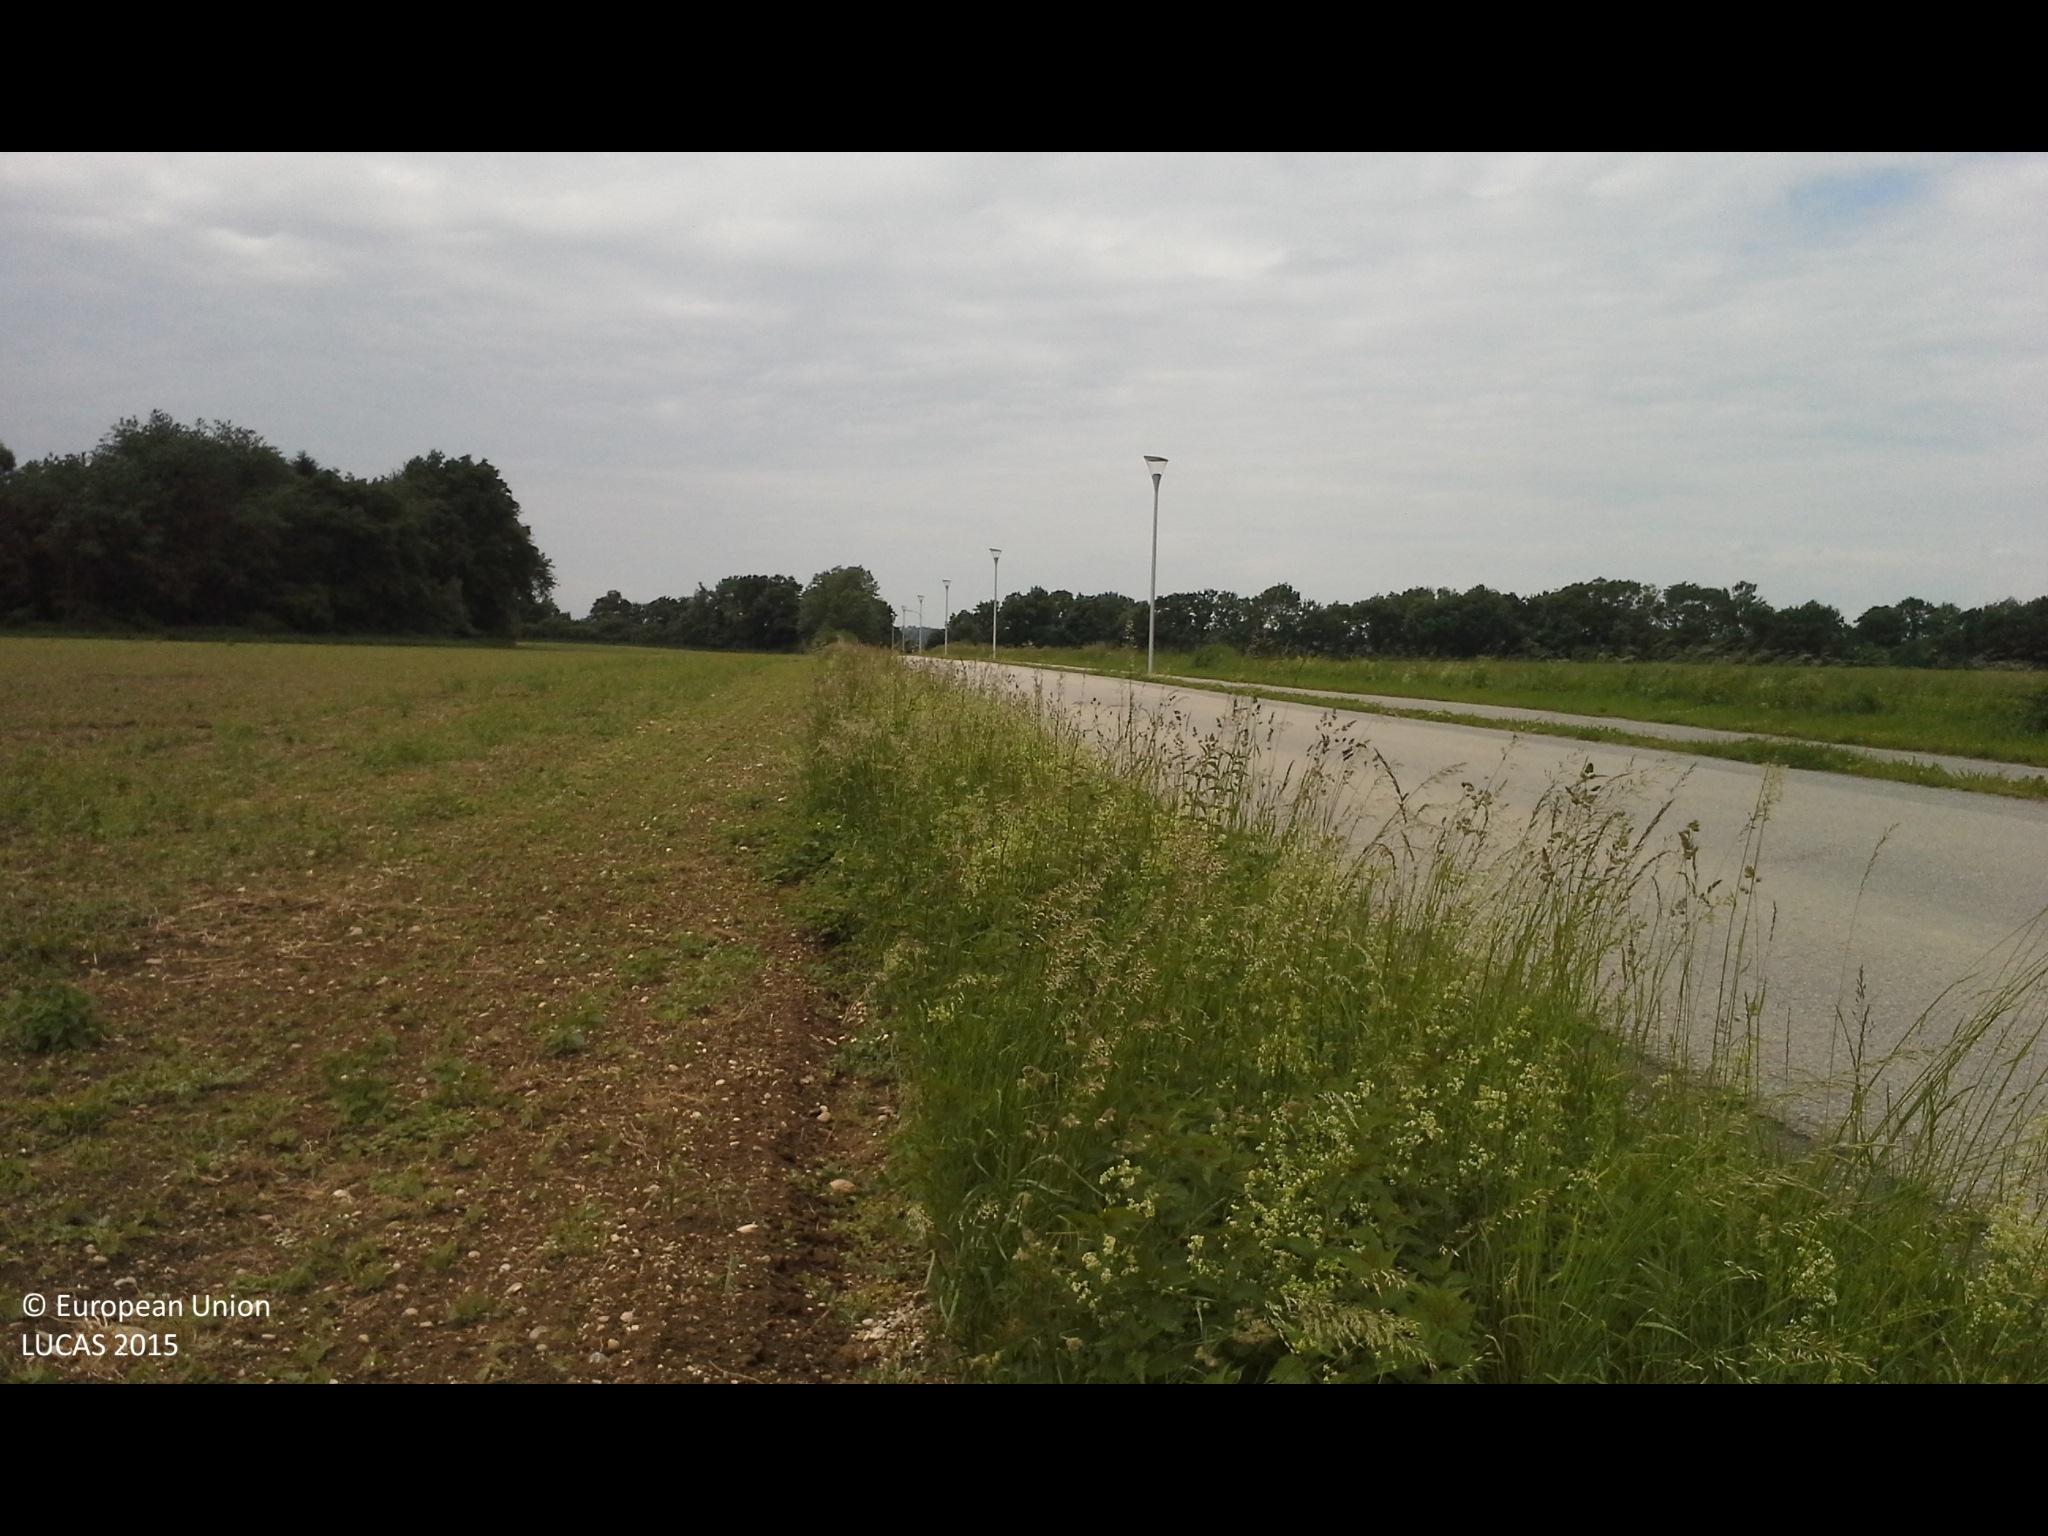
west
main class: Cropland
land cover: Soya
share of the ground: 10 - 25 %
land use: Agriculture (excluding fallow land and kitchen gardens)
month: May
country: AT
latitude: 48.1676
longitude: 14.5047
